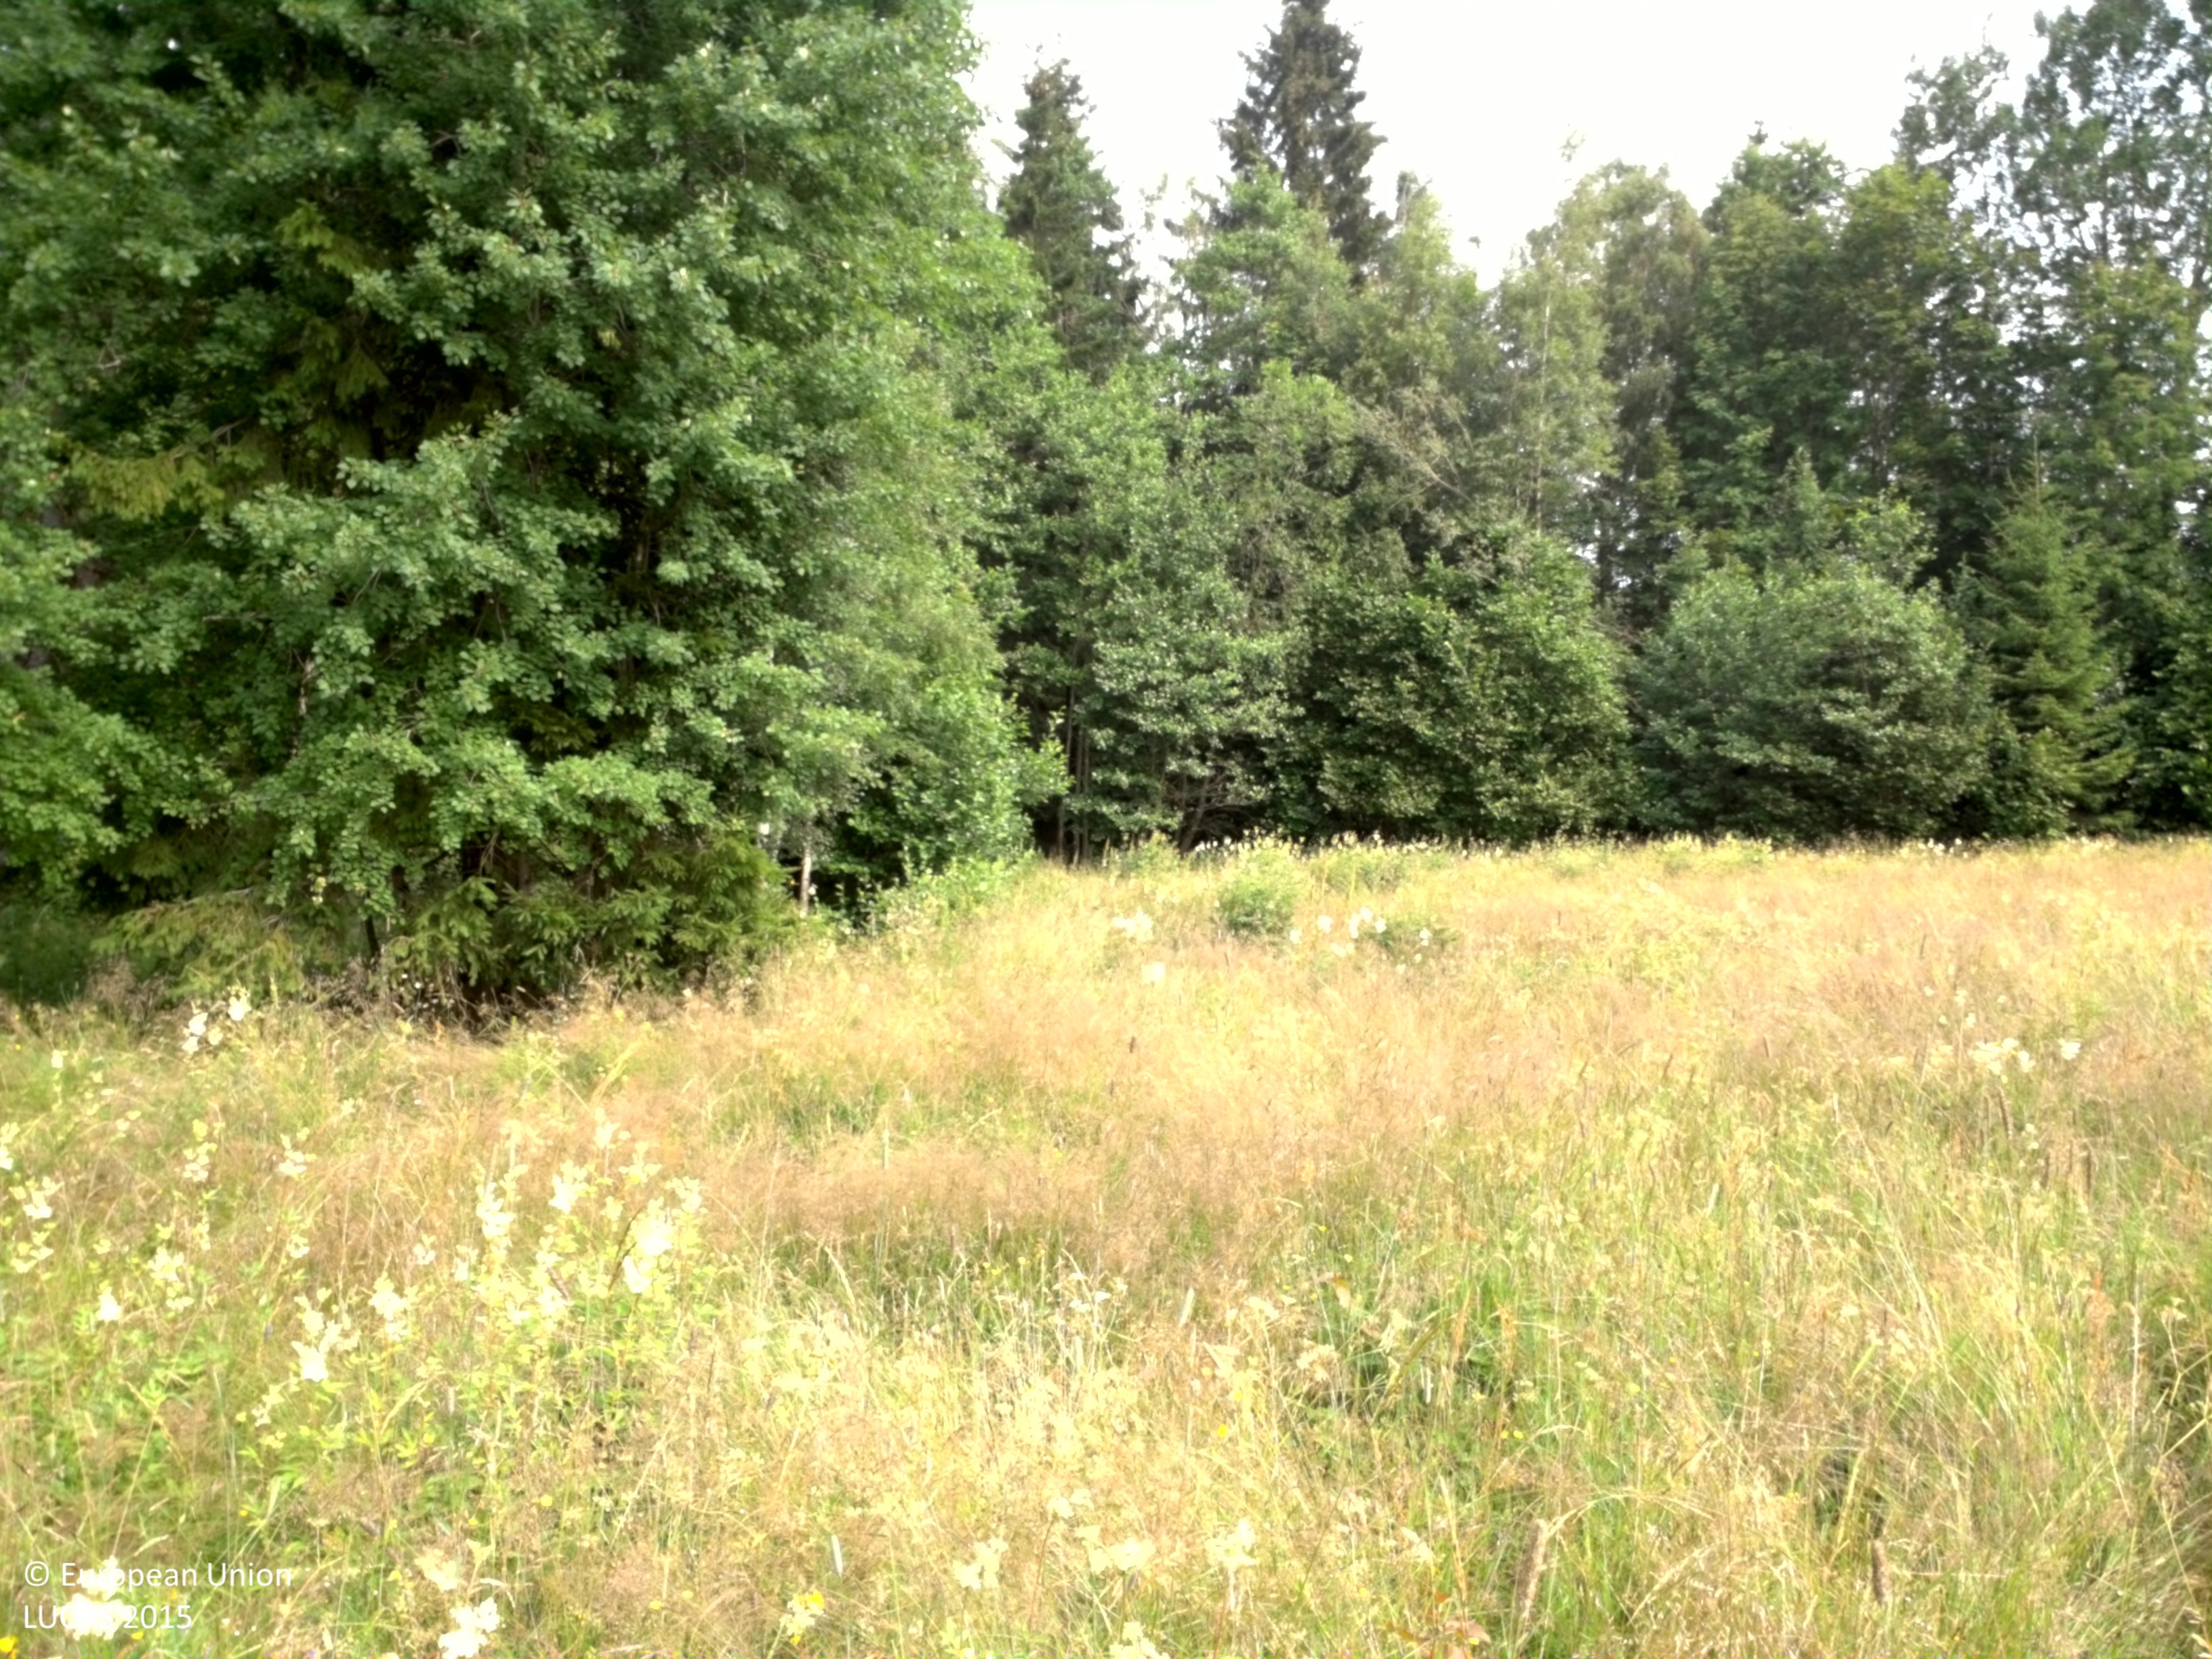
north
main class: Grassland
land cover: Grassland with sparse tree/shrub cover
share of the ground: > 75 %
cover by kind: herbaceous plants 90 %, broadleaved forest trees 5 %, shrubs 5 %
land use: Agriculture (excluding fallow land and kitchen gardens)
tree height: < 5 m
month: July
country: SE
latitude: 58.6715
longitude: 14.3557
